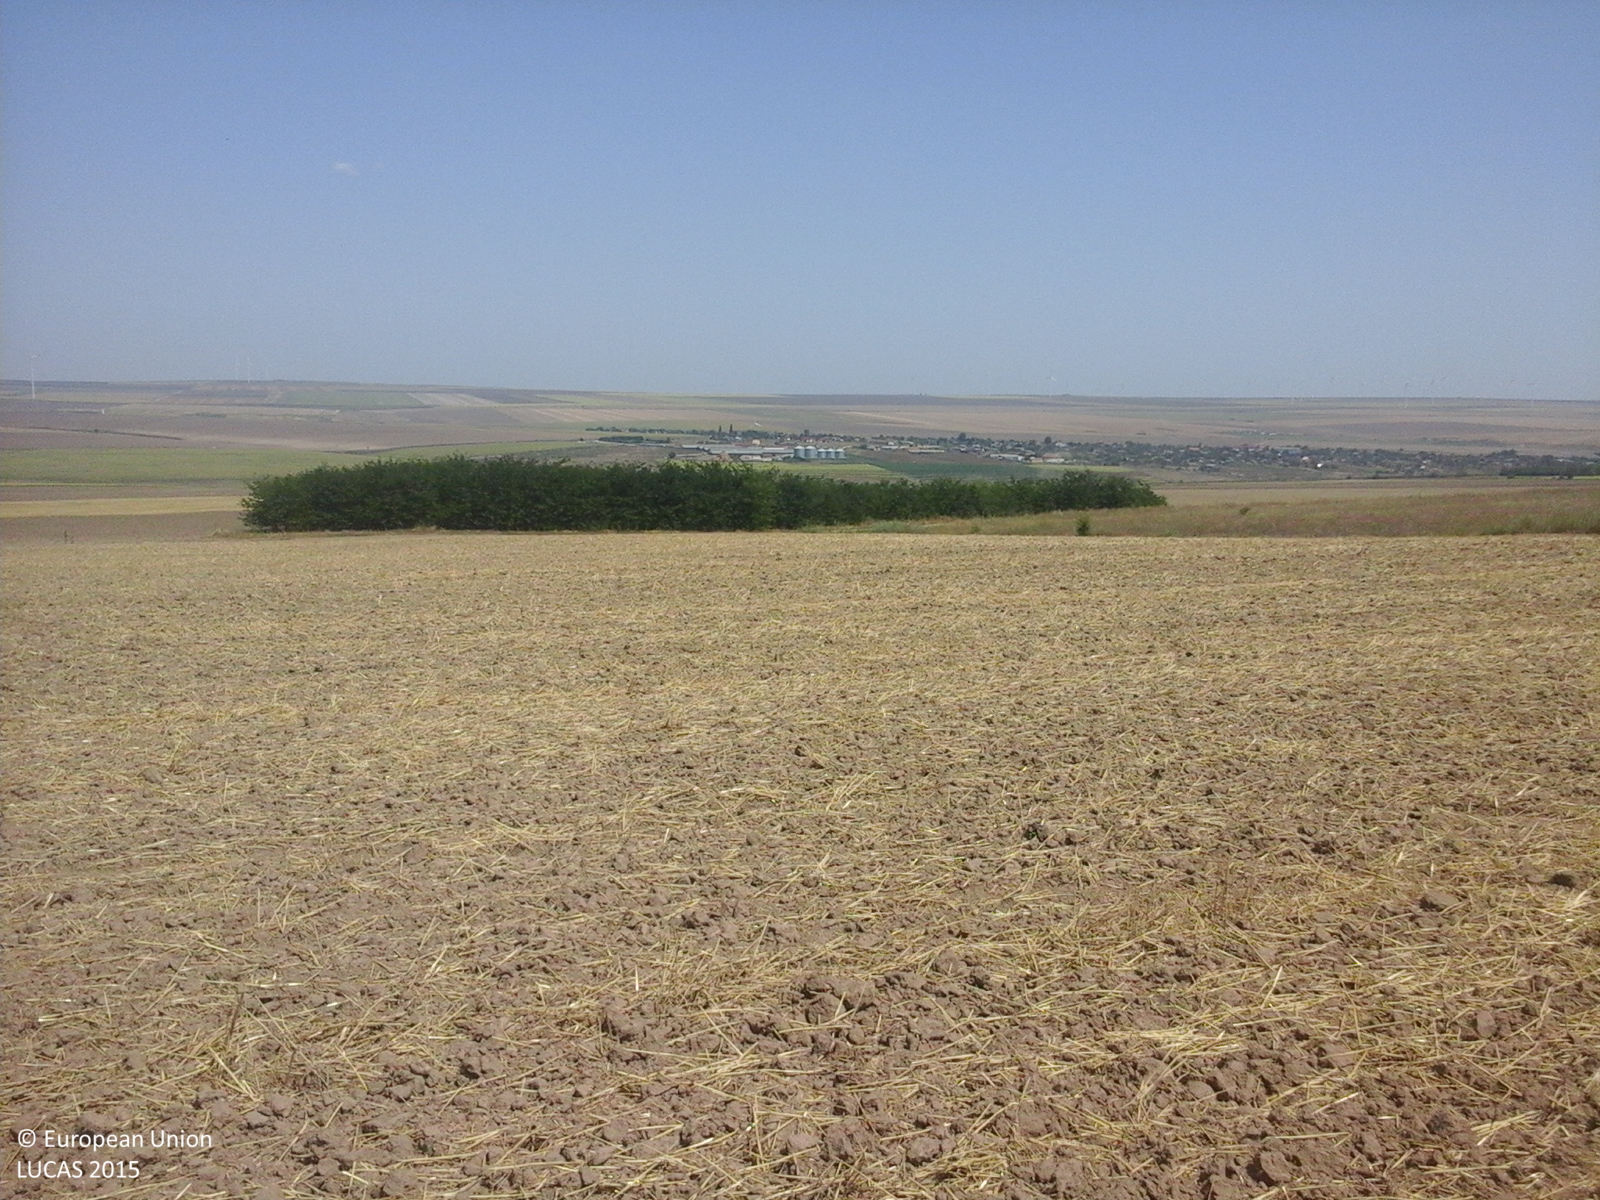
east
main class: Cropland
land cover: Common wheat
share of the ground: 10 - 25 %
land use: Agriculture (excluding fallow land and kitchen gardens)
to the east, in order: Common wheat; Grassland without tree/shrub cover; Tracks; Grass margins; Broadleaved woodland
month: August
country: RO
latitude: 44.5331
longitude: 28.1974
